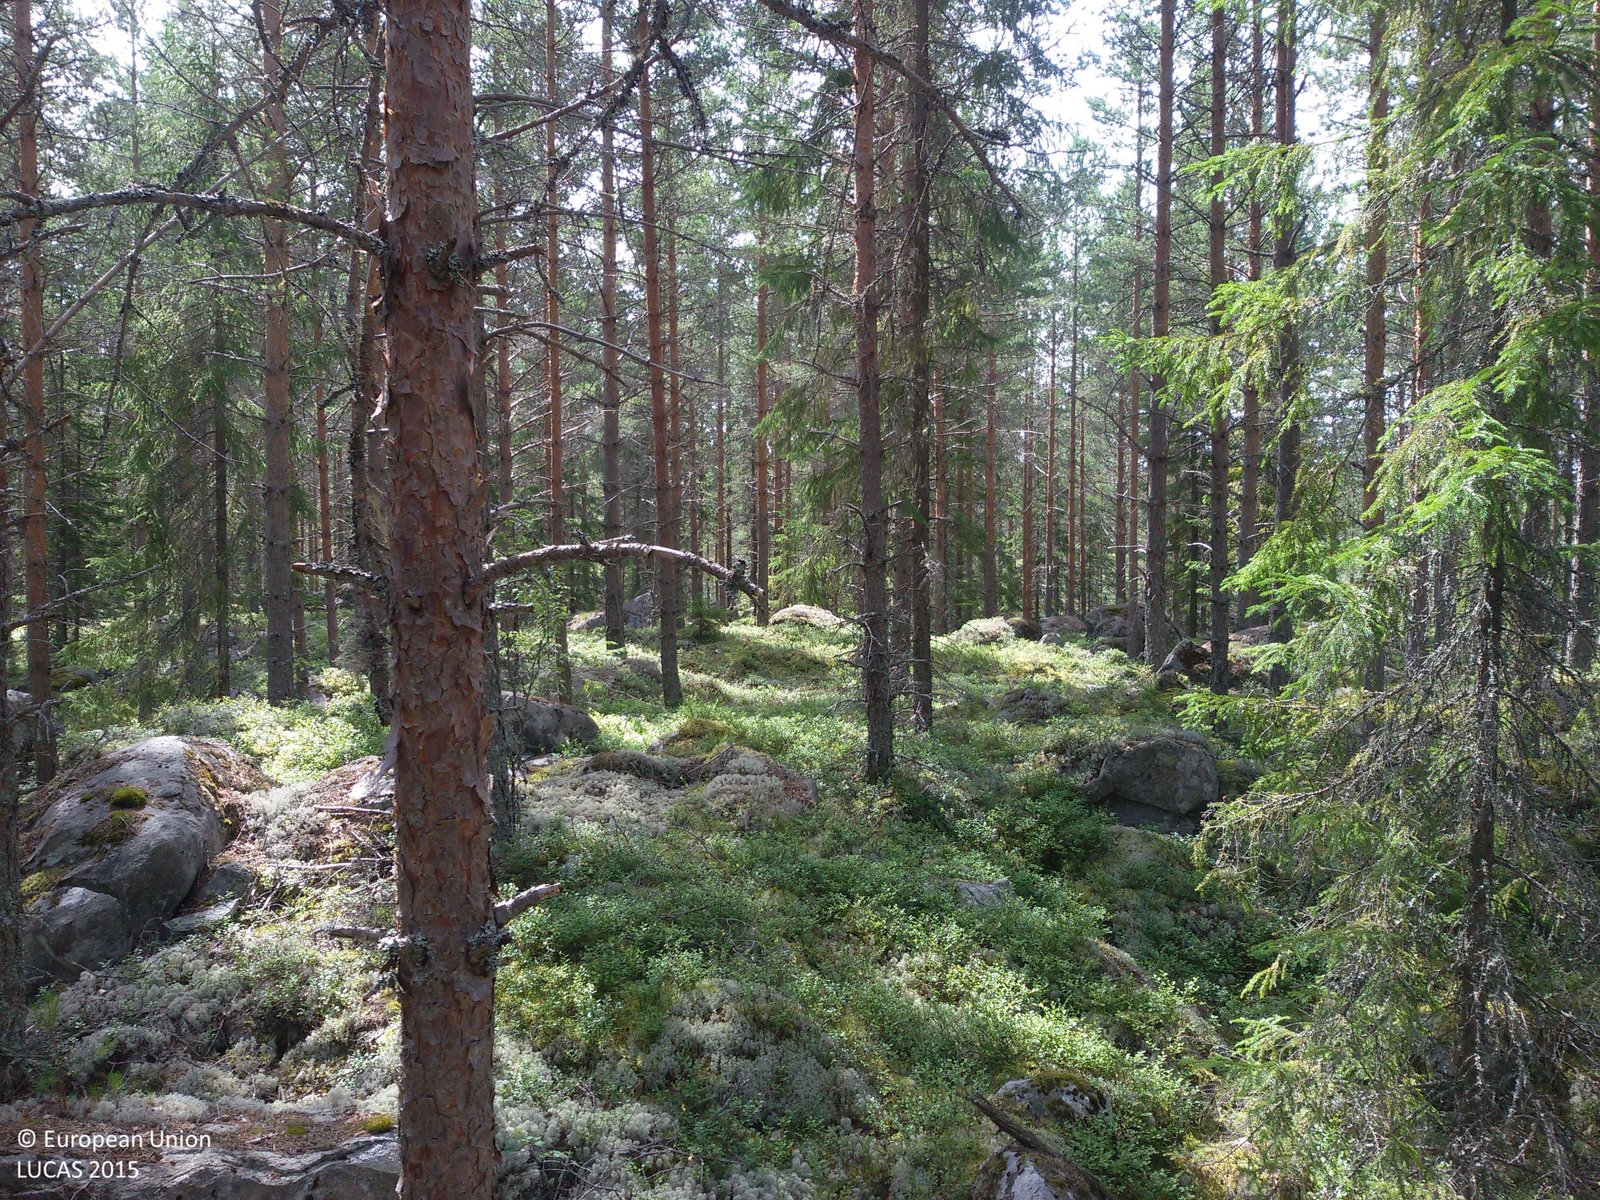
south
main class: Woodland
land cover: Pine dominated coniferous woodland
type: boreal forest
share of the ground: > 75 %
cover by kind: coniferous forest trees 80 %, shrubs 15 %, lichens and mosses 5 %
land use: Forestry
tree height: > 5 m
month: July
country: SE
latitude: 60.6362
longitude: 15.4170
